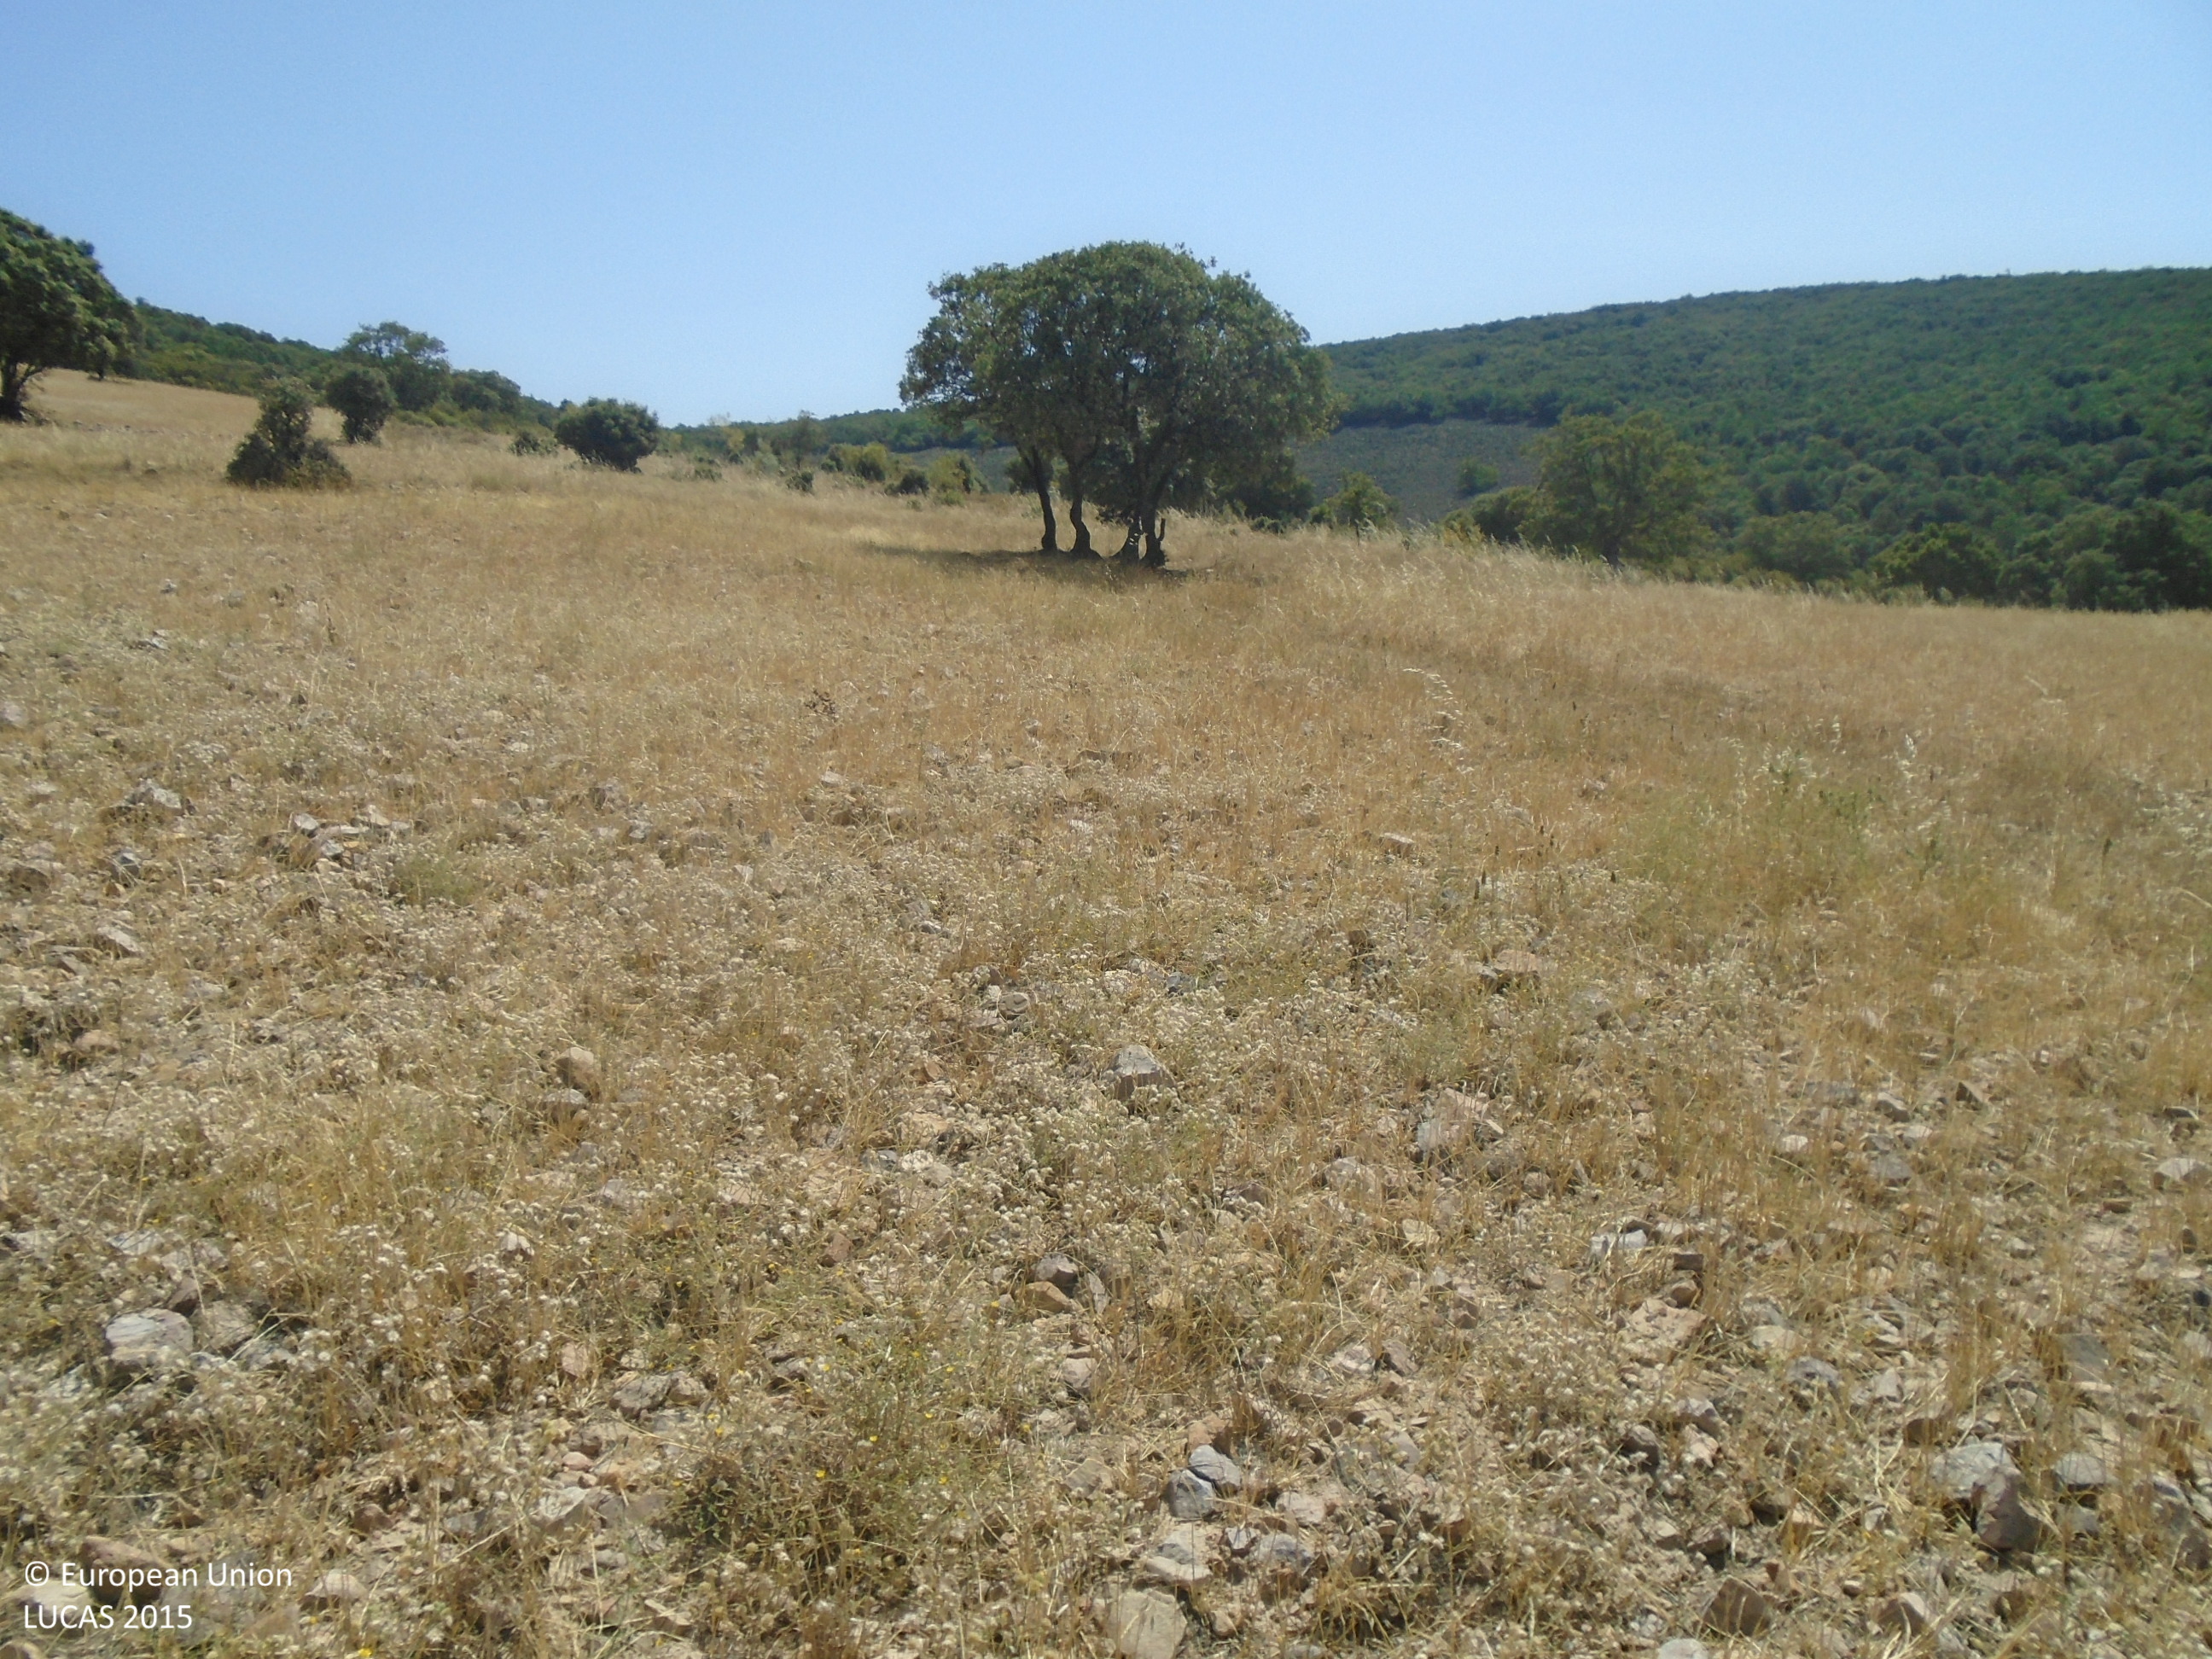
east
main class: Grassland
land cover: Spontaneously vegetated surfaces
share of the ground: > 75 %
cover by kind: herbaceous plants 80 %, consolidated bare surface 20 %
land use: Agriculture (excluding fallow land and kitchen gardens)
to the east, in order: Spontaneously vegetated surfaces; Grass margins; Grassland with sparse tree/shrub cover; Broadleaved woodland
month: July
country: ES
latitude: 39.3383
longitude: -4.0778
